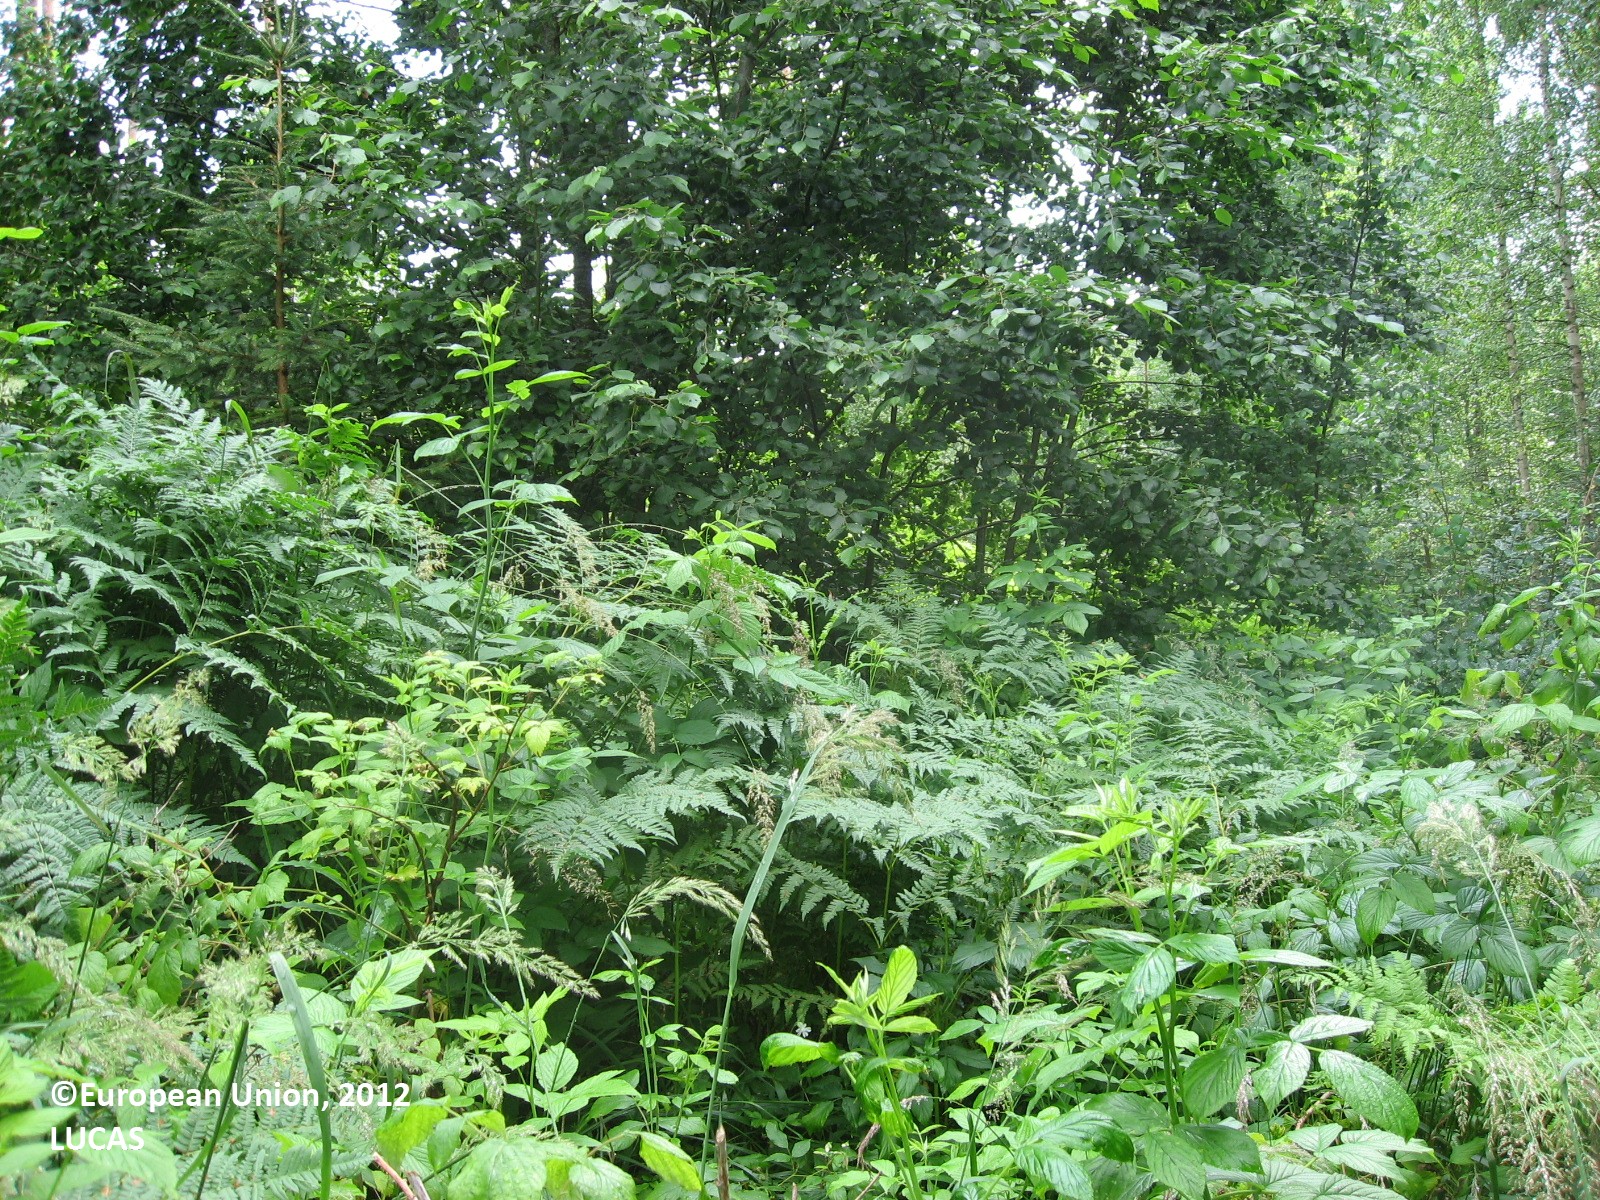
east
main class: Shrubland
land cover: Shrubland with sparse tree cover
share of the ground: > 75 %
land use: Forestry
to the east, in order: Shrubland with sparse tree cover; Other mixed woodland; Shrubland with sparse tree cover; Other mixed woodland; Spontaneously vegetated surfaces; Other mixed woodland; Spontaneously vegetated surfaces; Other mixed woodland
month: July
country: FI
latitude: 61.2796
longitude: 25.8965
